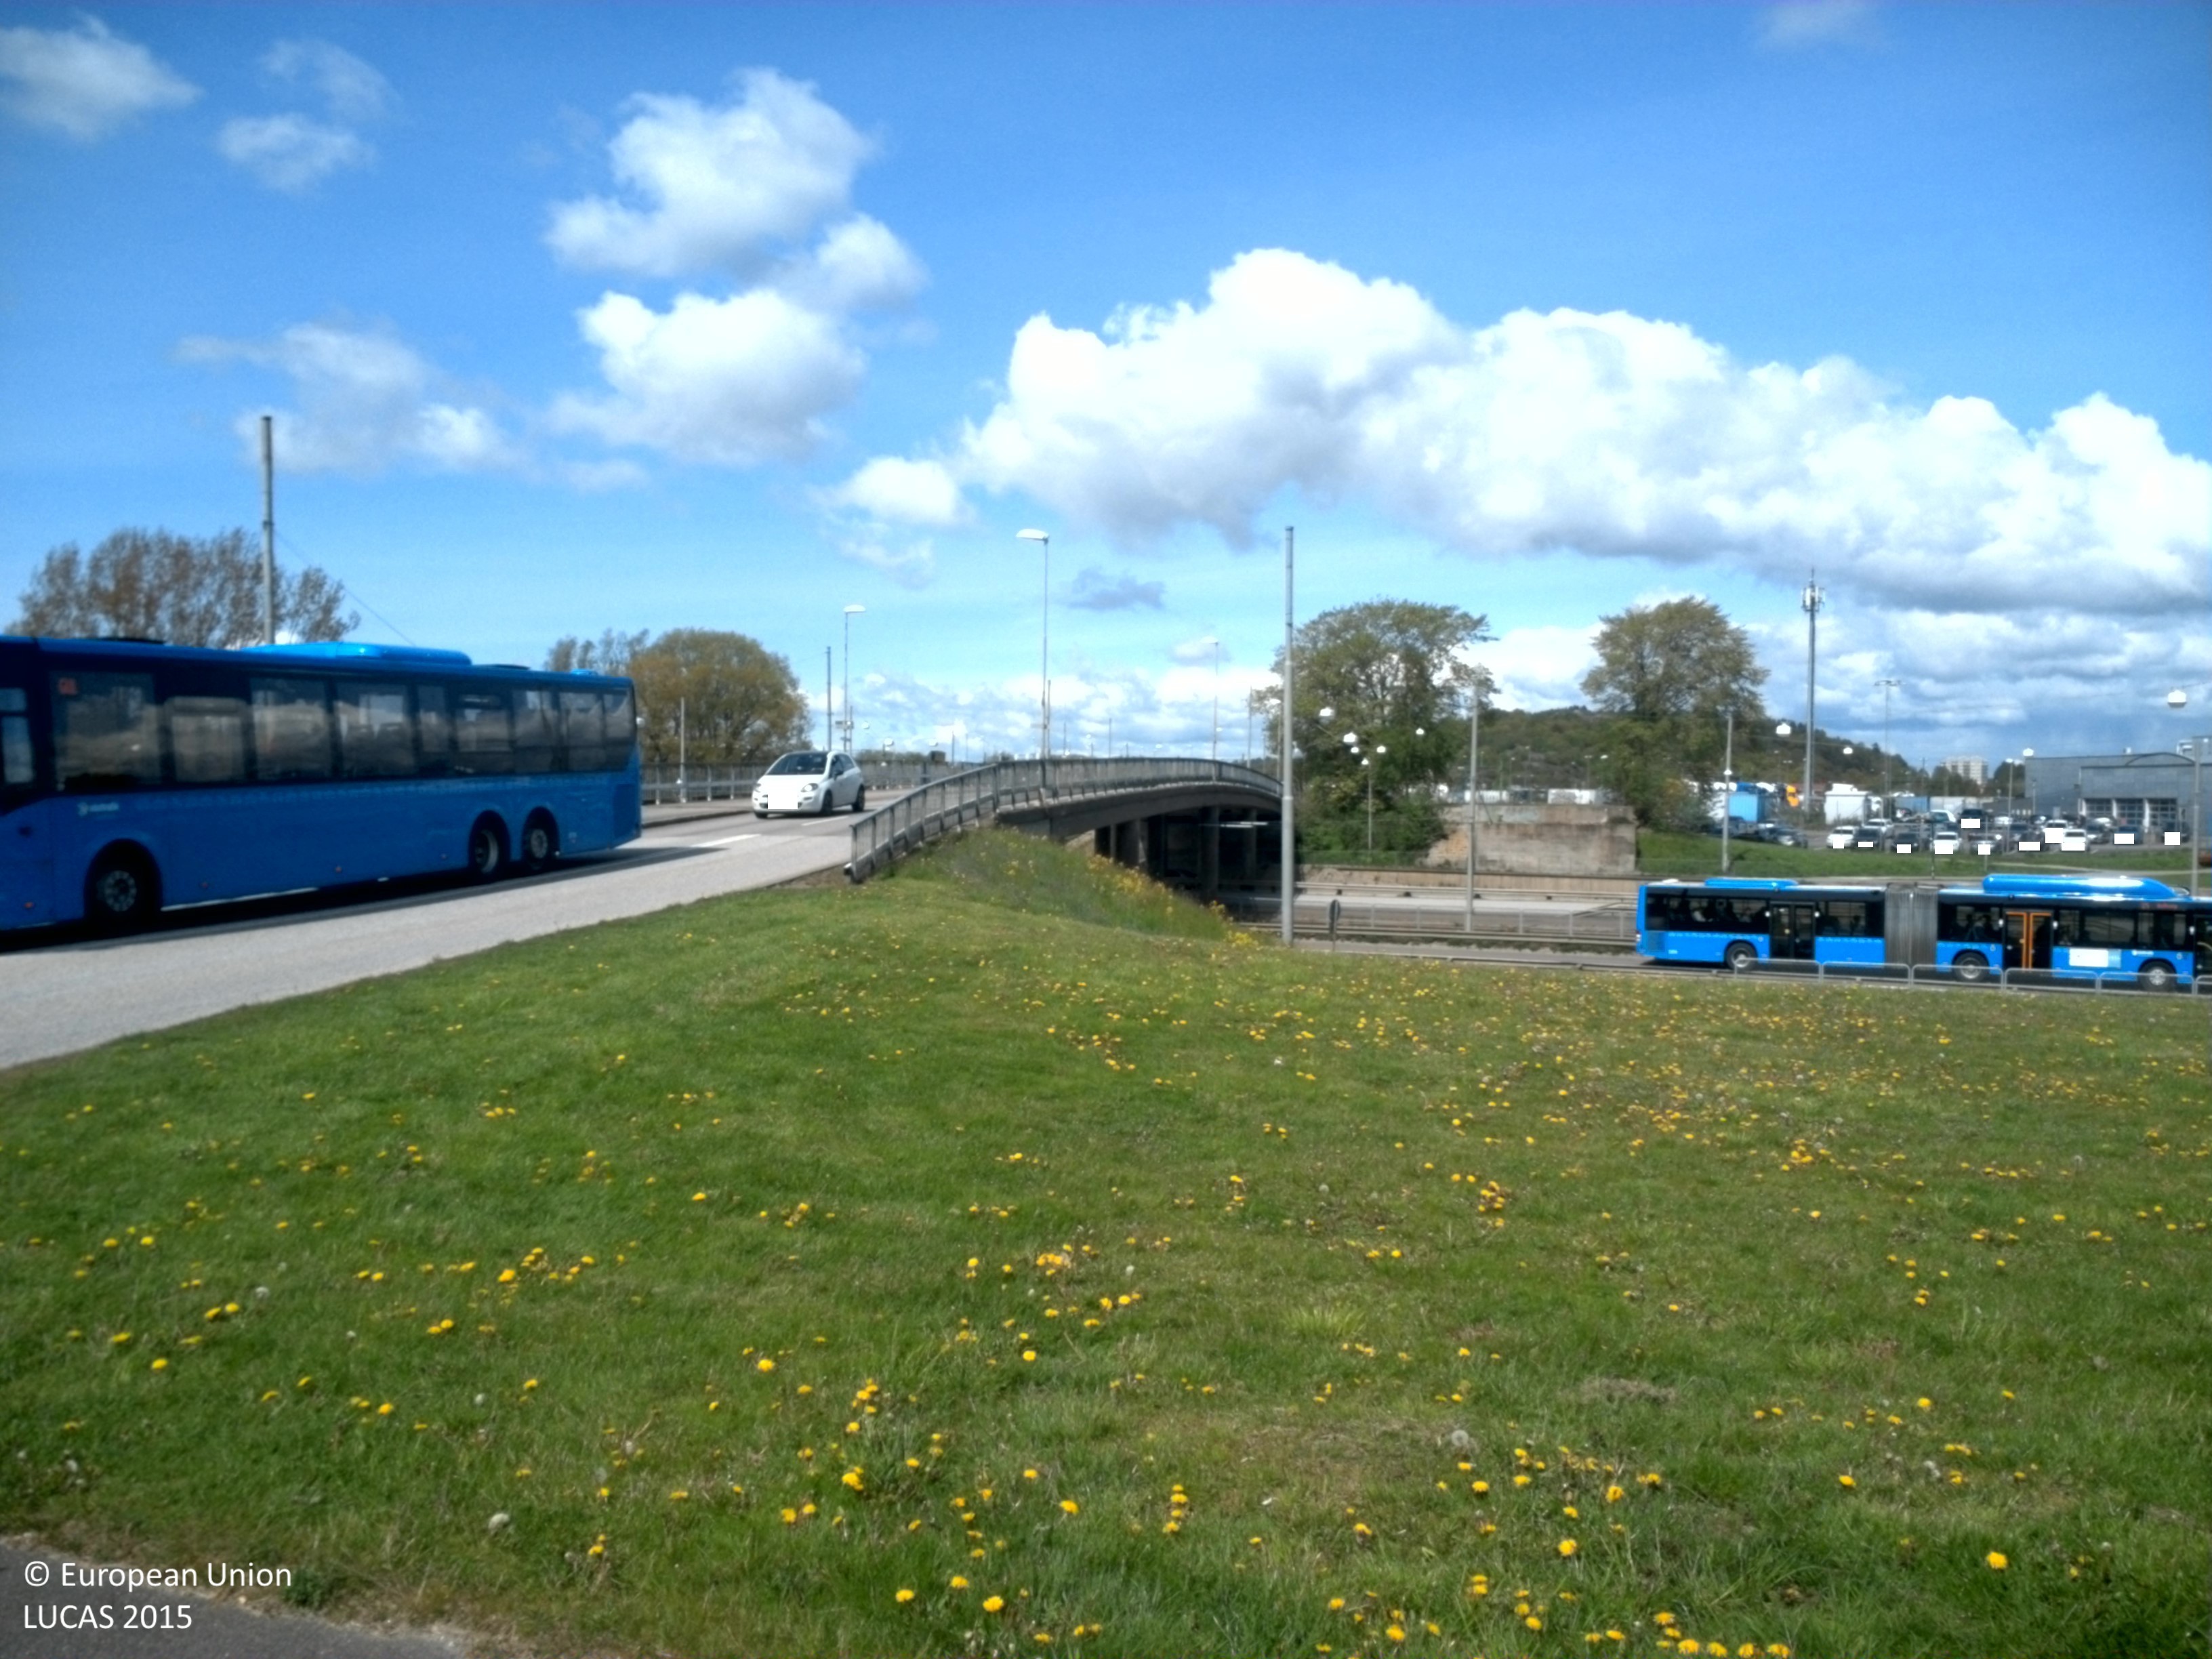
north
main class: Grassland
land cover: Grassland with sparse tree/shrub cover
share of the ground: > 75 %
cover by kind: herbaceous plants 95 %, broadleaved forest trees 5 %
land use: Road transport
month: May
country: SE
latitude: 57.7195
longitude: 11.9609
